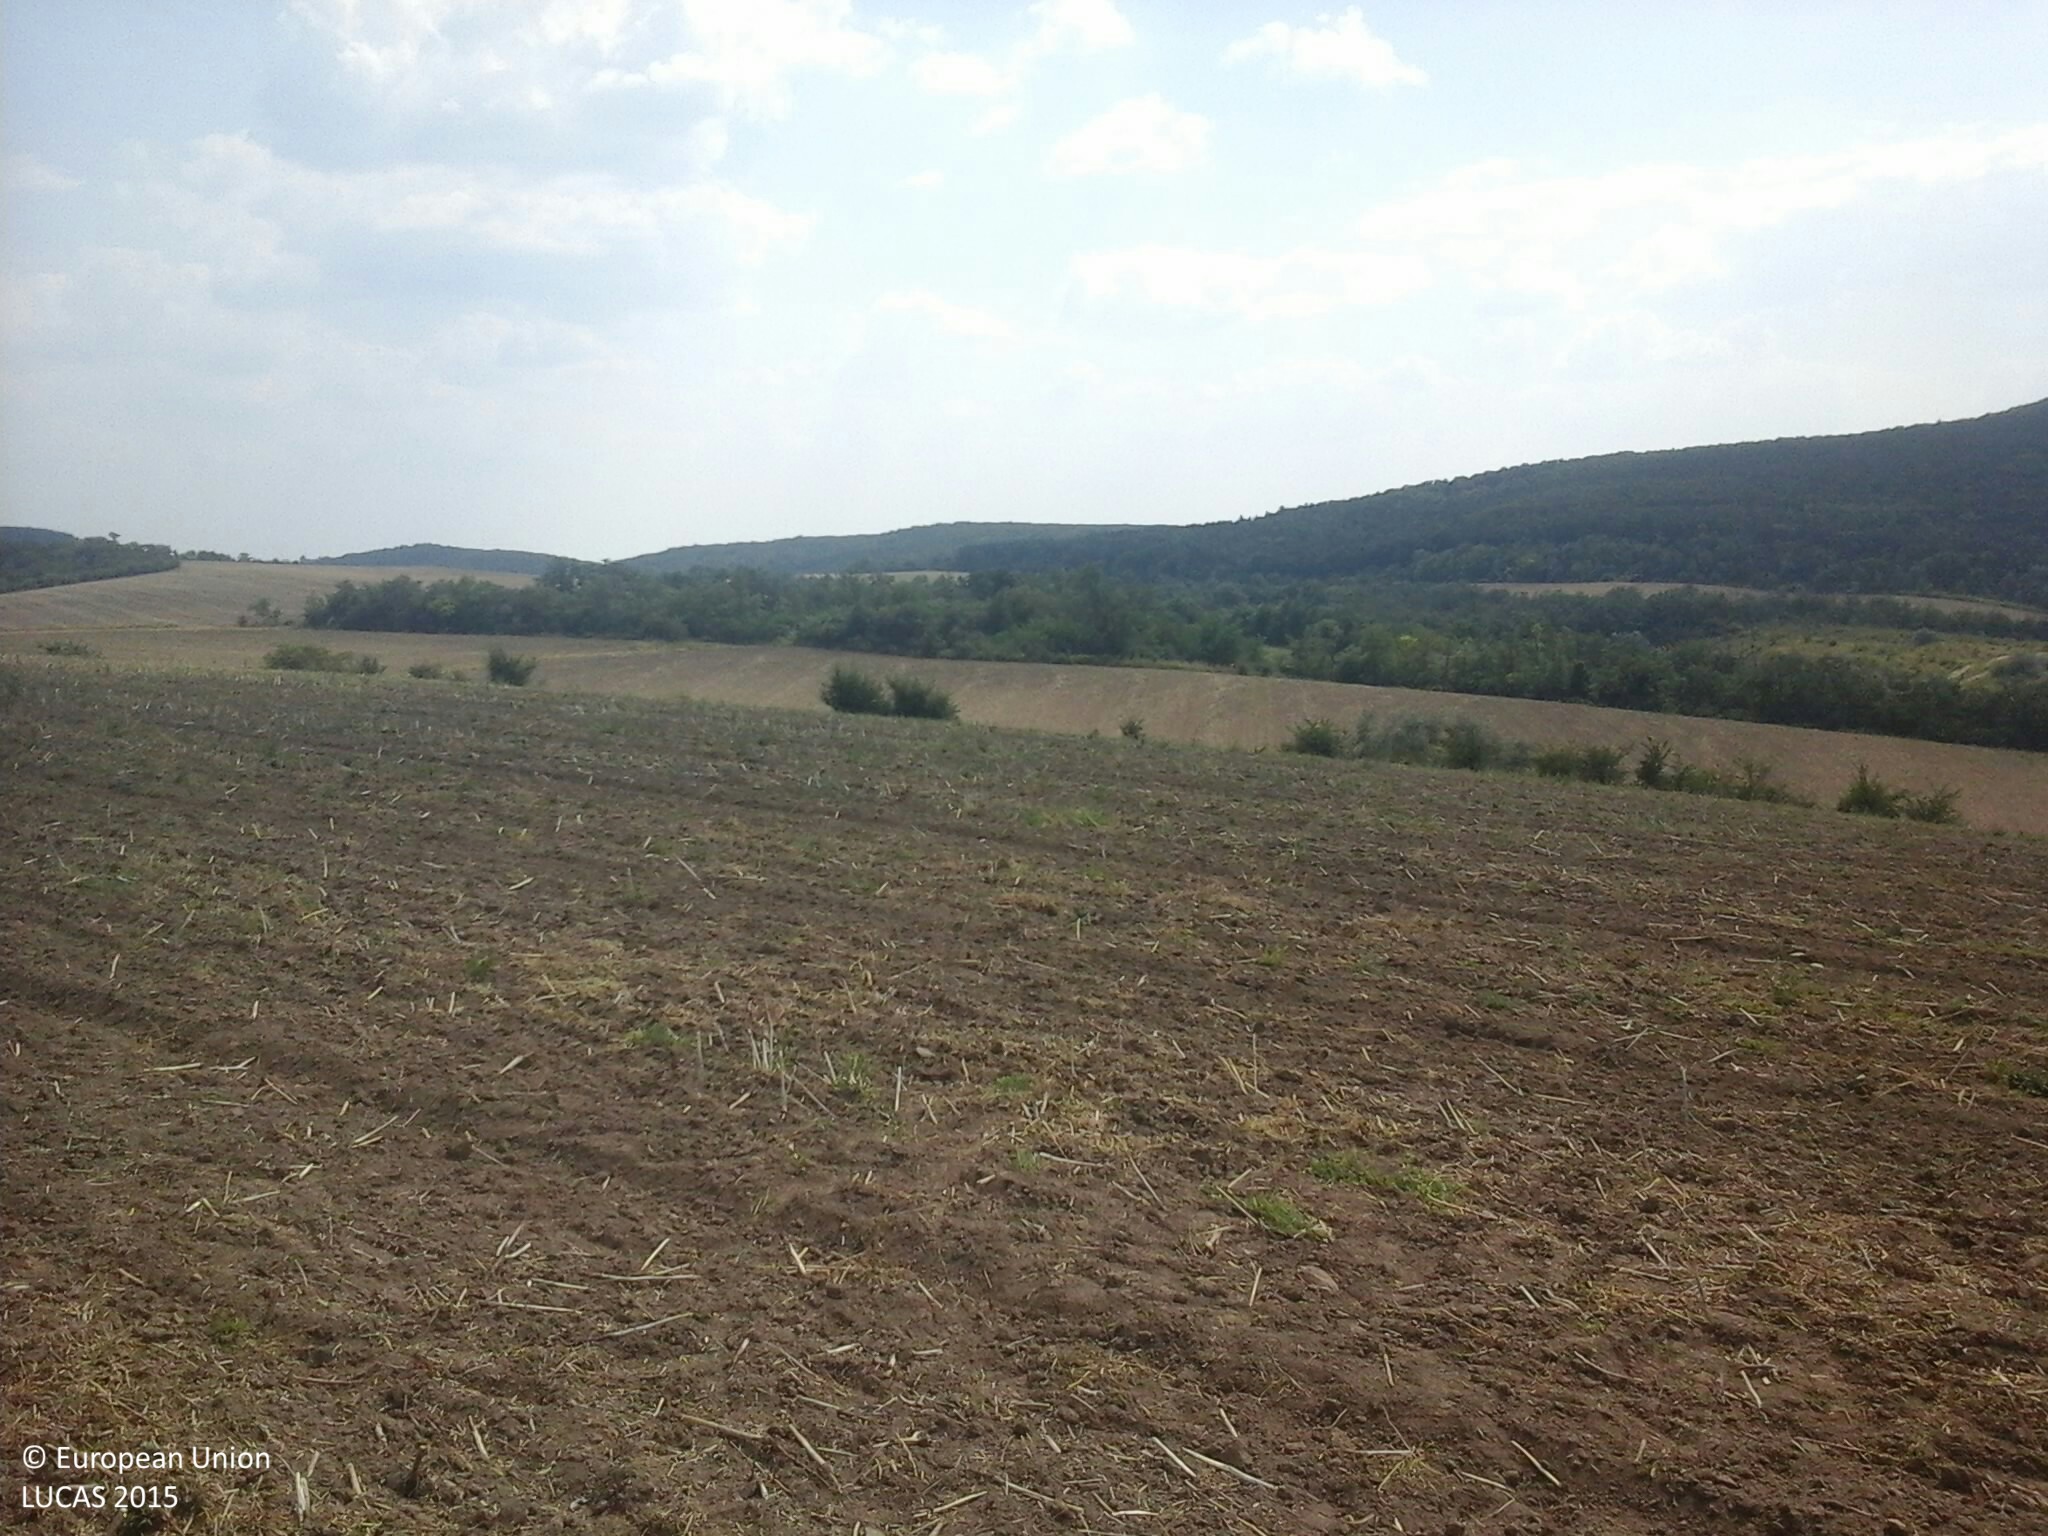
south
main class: Cropland
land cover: Rape and turnip rape
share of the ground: < 10 %
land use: Agriculture (excluding fallow land and kitchen gardens)
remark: Harvested field
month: August
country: HU
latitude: 47.7430
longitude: 18.5908
